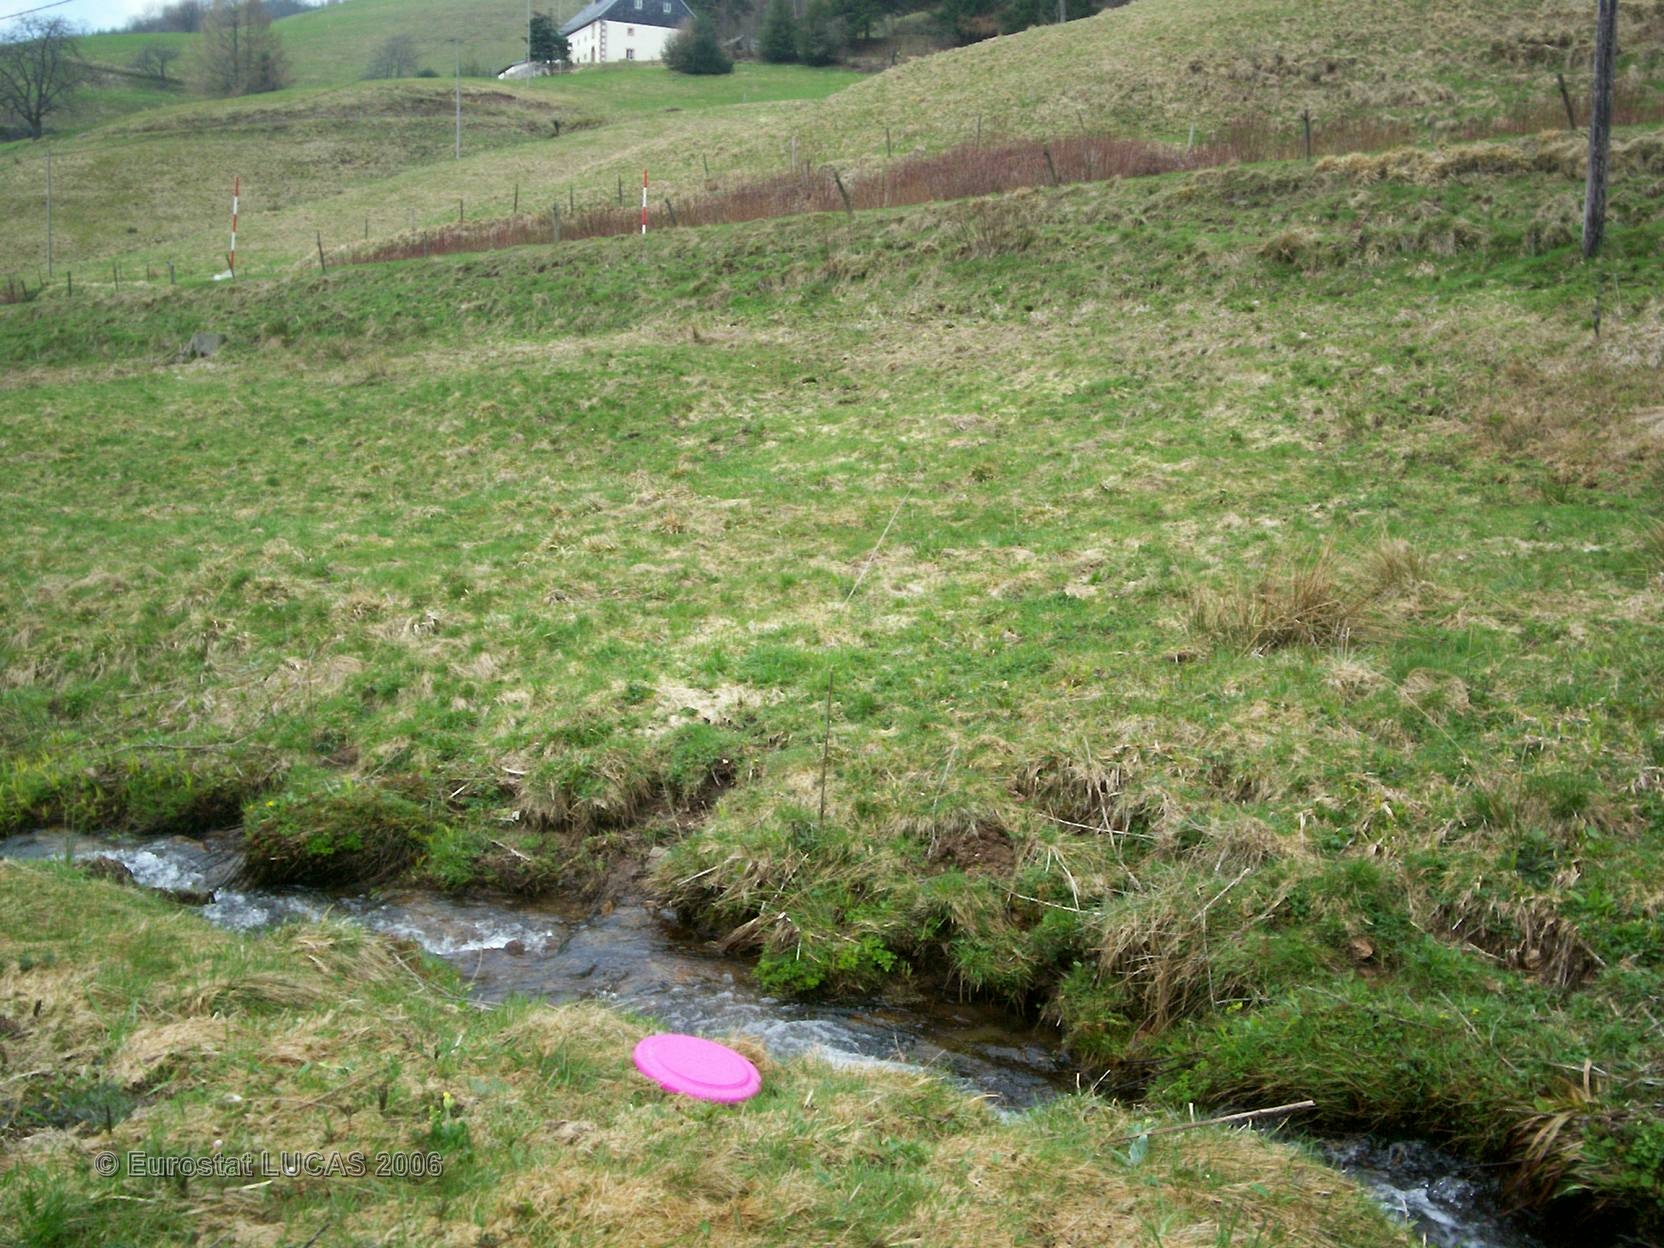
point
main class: Grassland
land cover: Grassland without tree/shrub cover
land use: Agriculture (excluding fallow land and kitchen gardens)
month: April
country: FR
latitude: 48.1857
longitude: 7.1091
